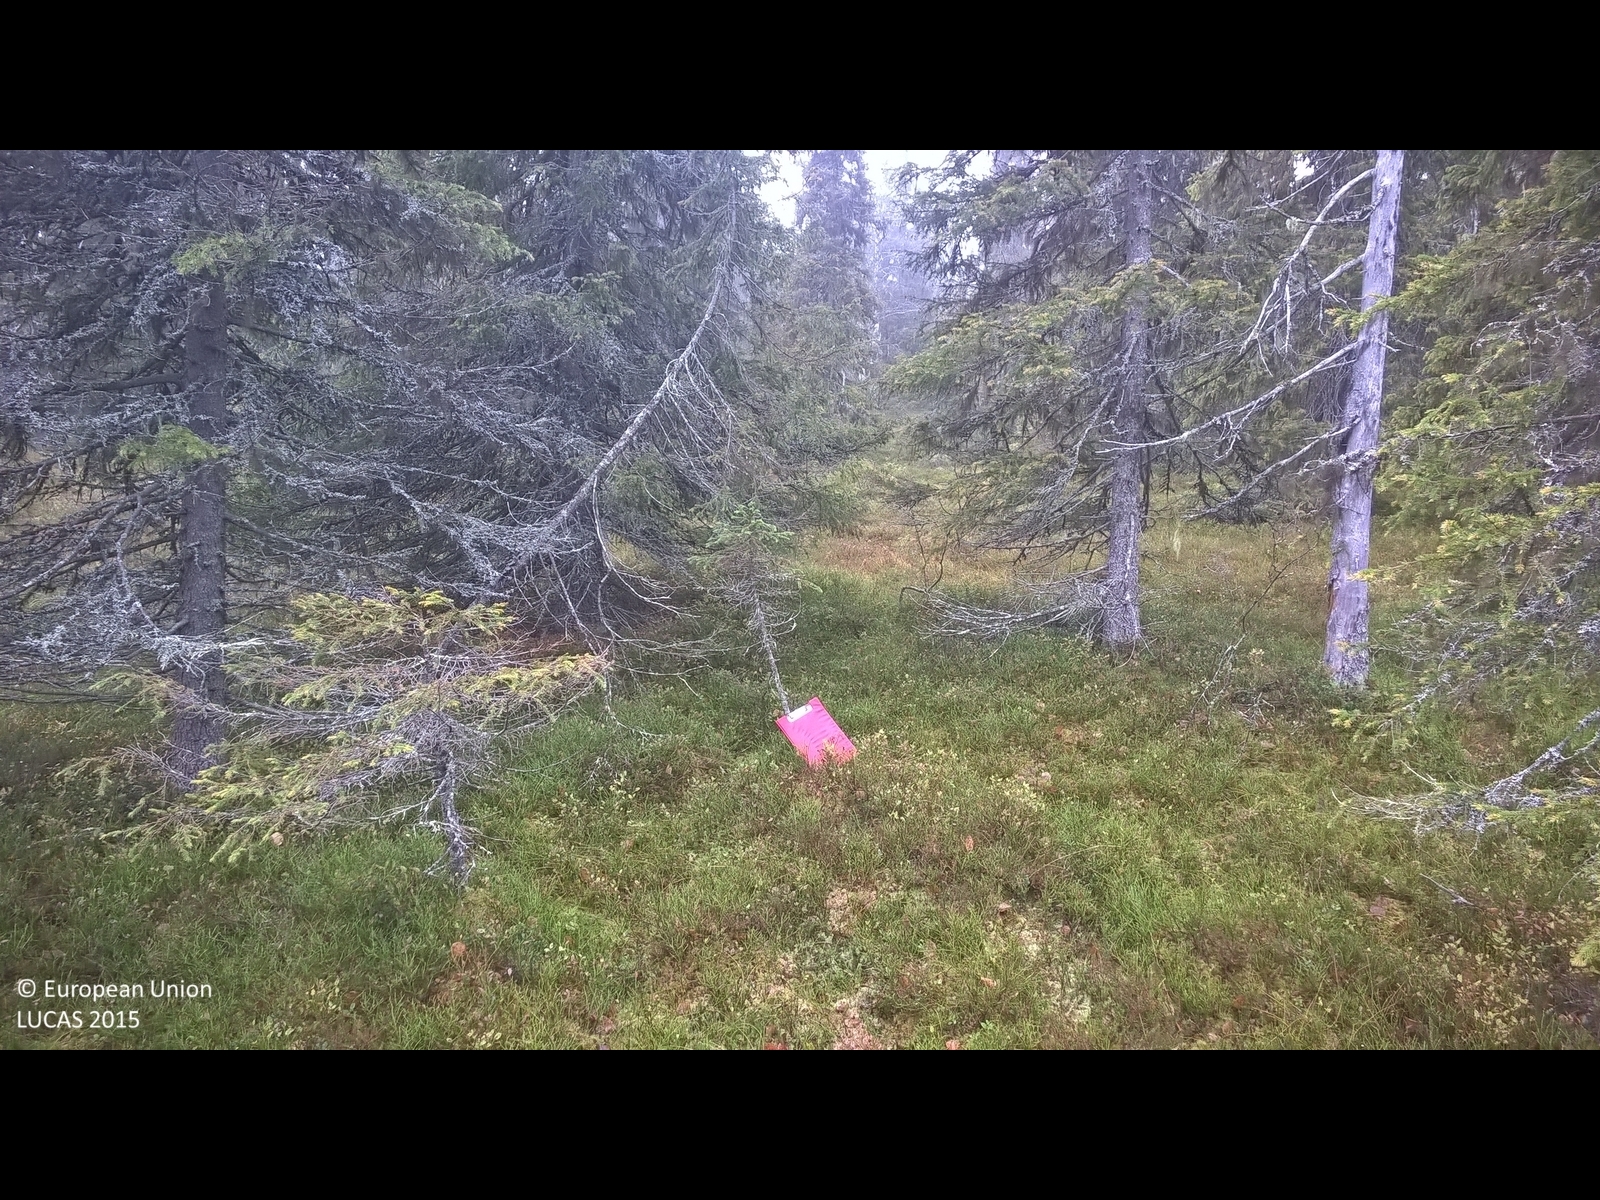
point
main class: Woodland
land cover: Spruce dominated coniferous woodland
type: boreal forest
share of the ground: > 75 %
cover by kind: coniferous forest trees 80 %, shrubs 15 %, lichens and mosses 5 %
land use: Forestry
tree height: > 5 m
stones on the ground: < 10 %
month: October
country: SE
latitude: 65.6458
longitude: 18.8044
